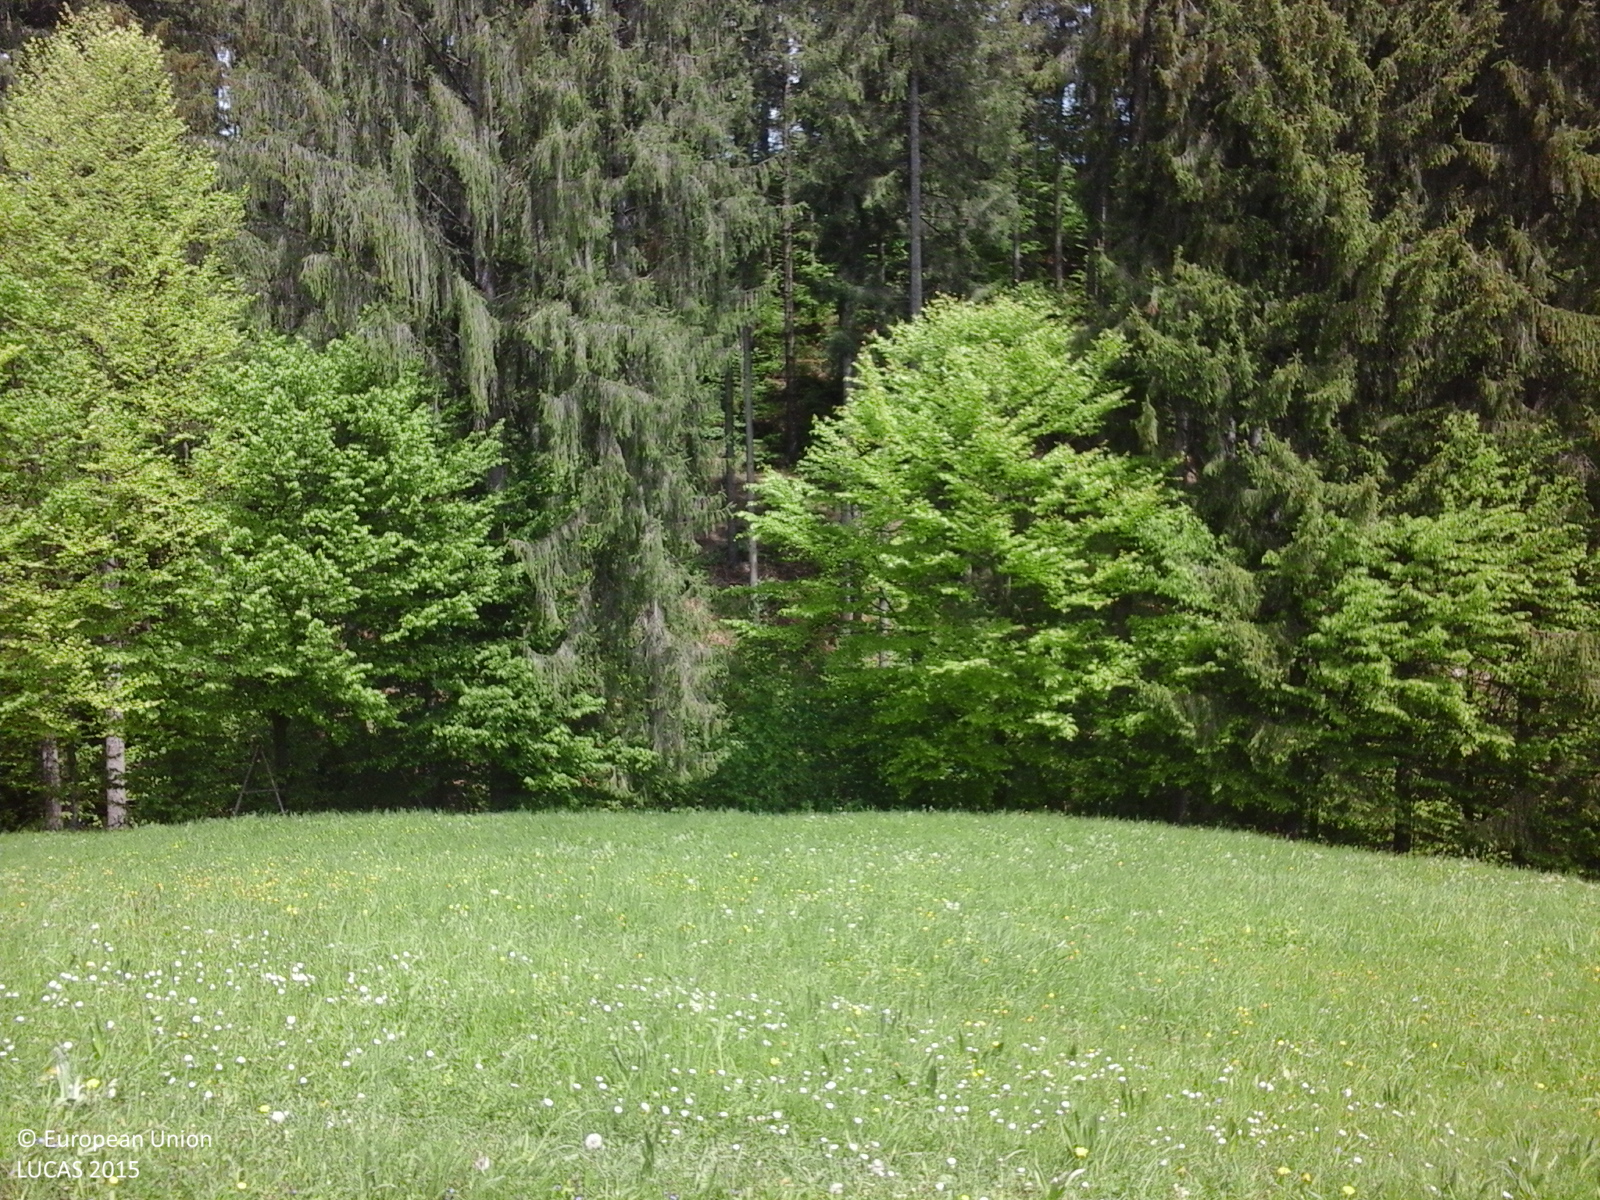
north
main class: Grassland
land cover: Grassland without tree/shrub cover
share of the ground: > 75 %
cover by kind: herbaceous plants 100 %
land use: Agriculture (excluding fallow land and kitchen gardens)
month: May
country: RO
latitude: 45.6371
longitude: 26.0881
